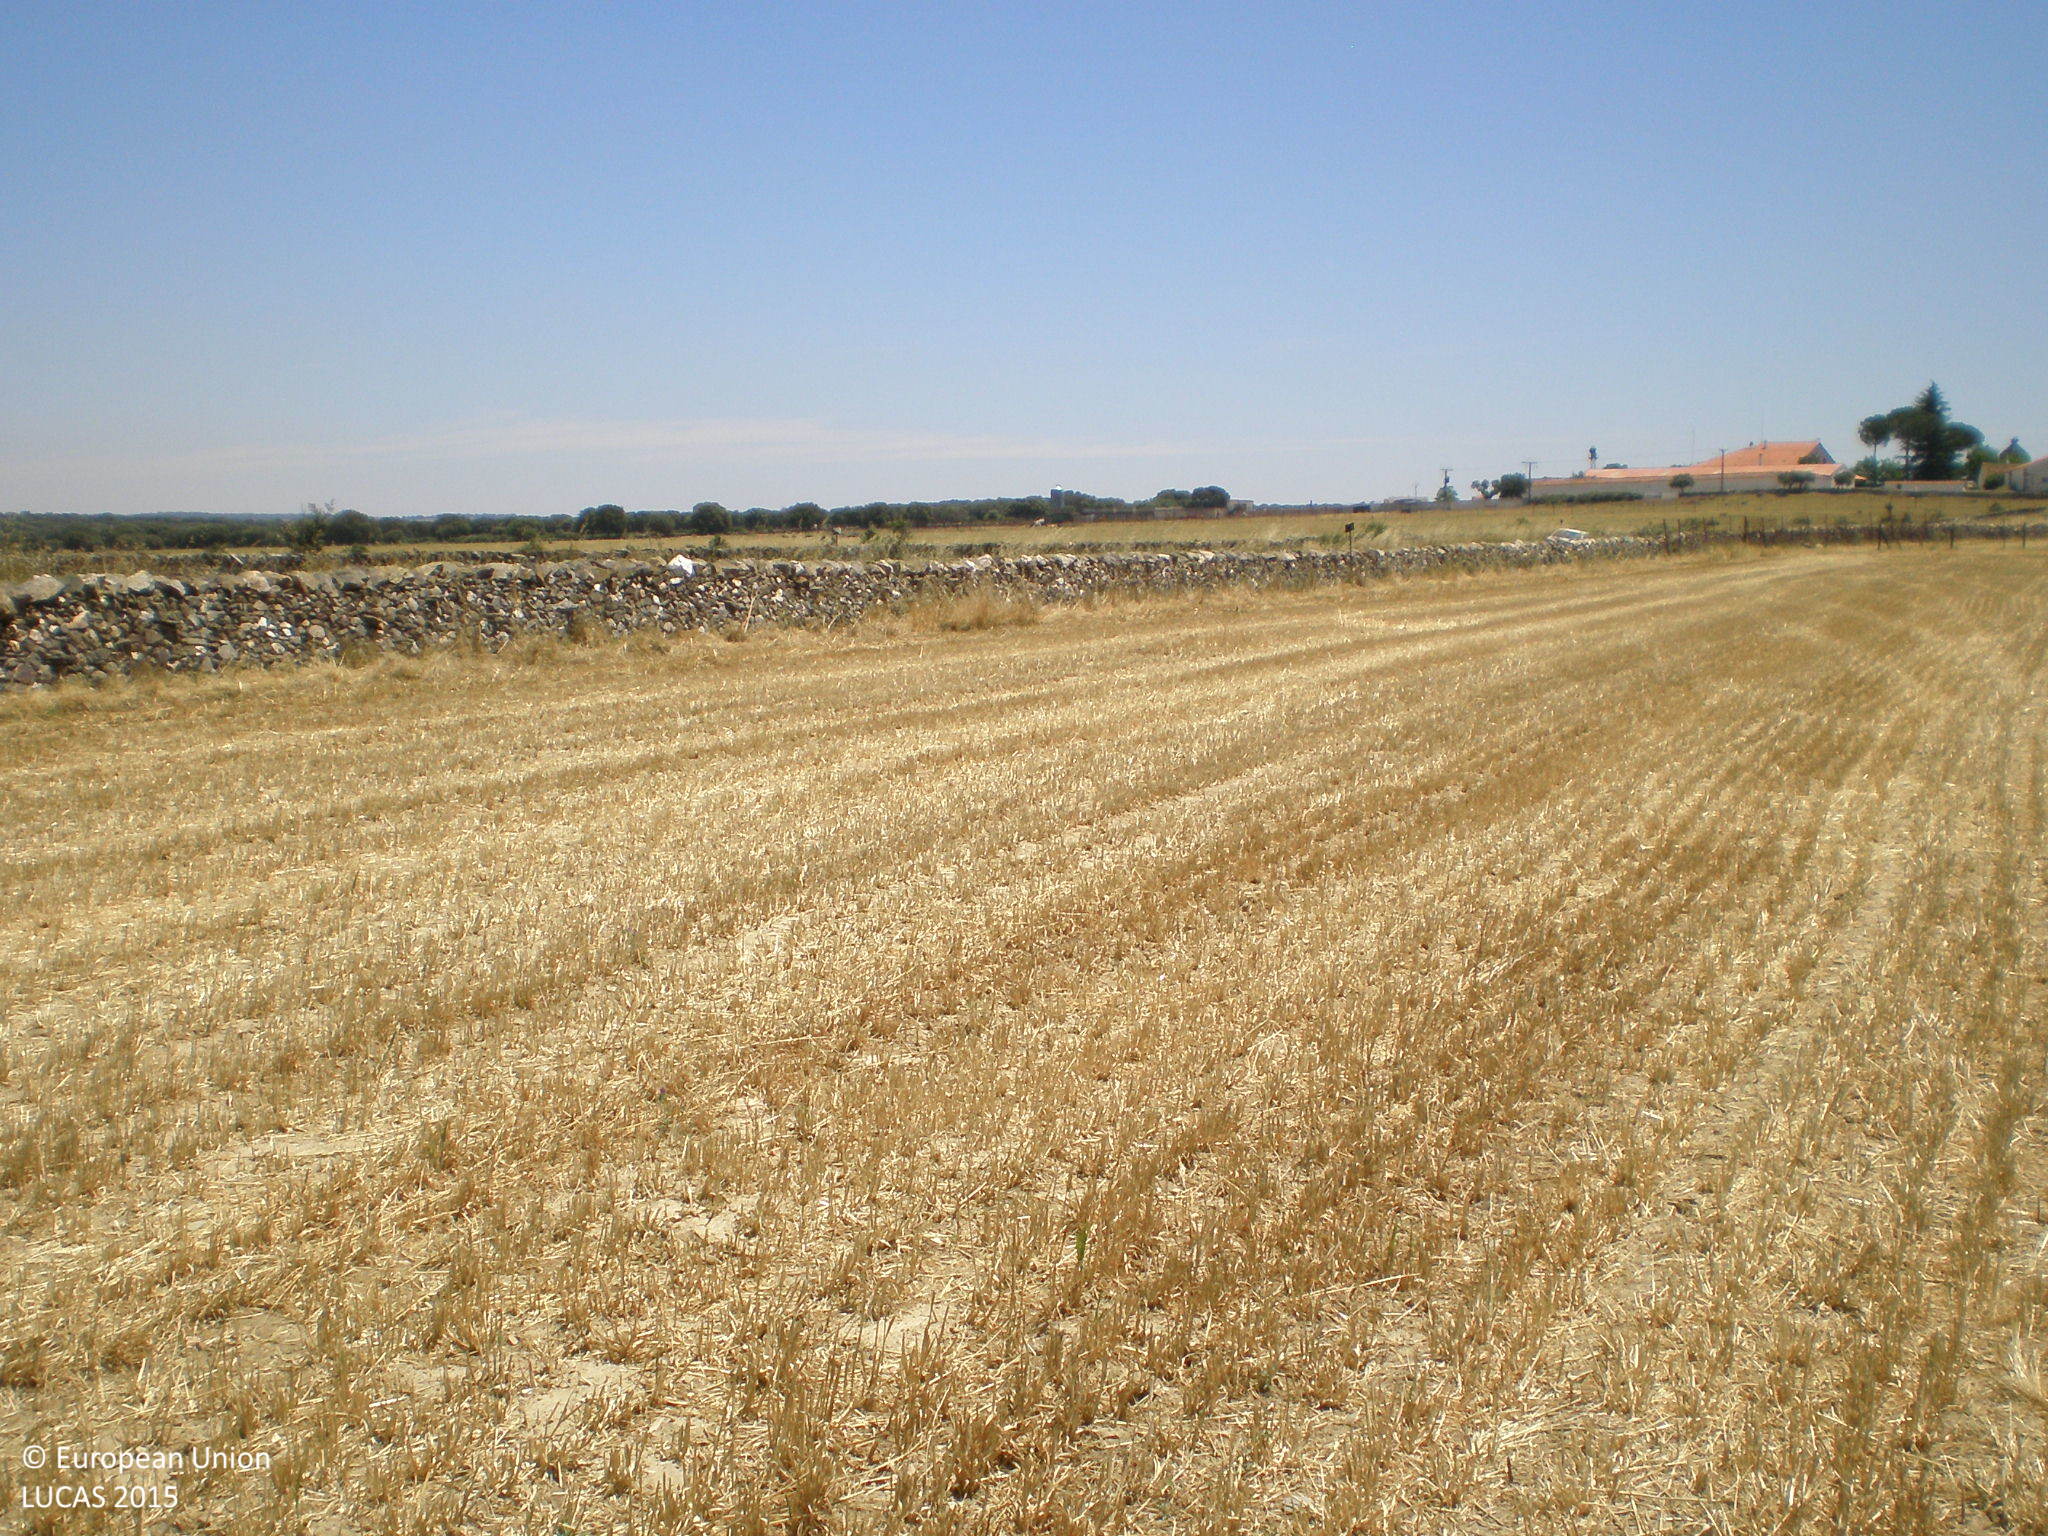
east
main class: Cropland
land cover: Oats
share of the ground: < 10 %
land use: Agriculture (excluding fallow land and kitchen gardens)
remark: Harvested field
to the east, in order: Oats; Dry stone walls; Grass margins; Paved roads, cycling and walking lanes; Grass margins; Grassland without tree/shrub cover
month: June
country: ES
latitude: 40.7547
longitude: -5.8430
